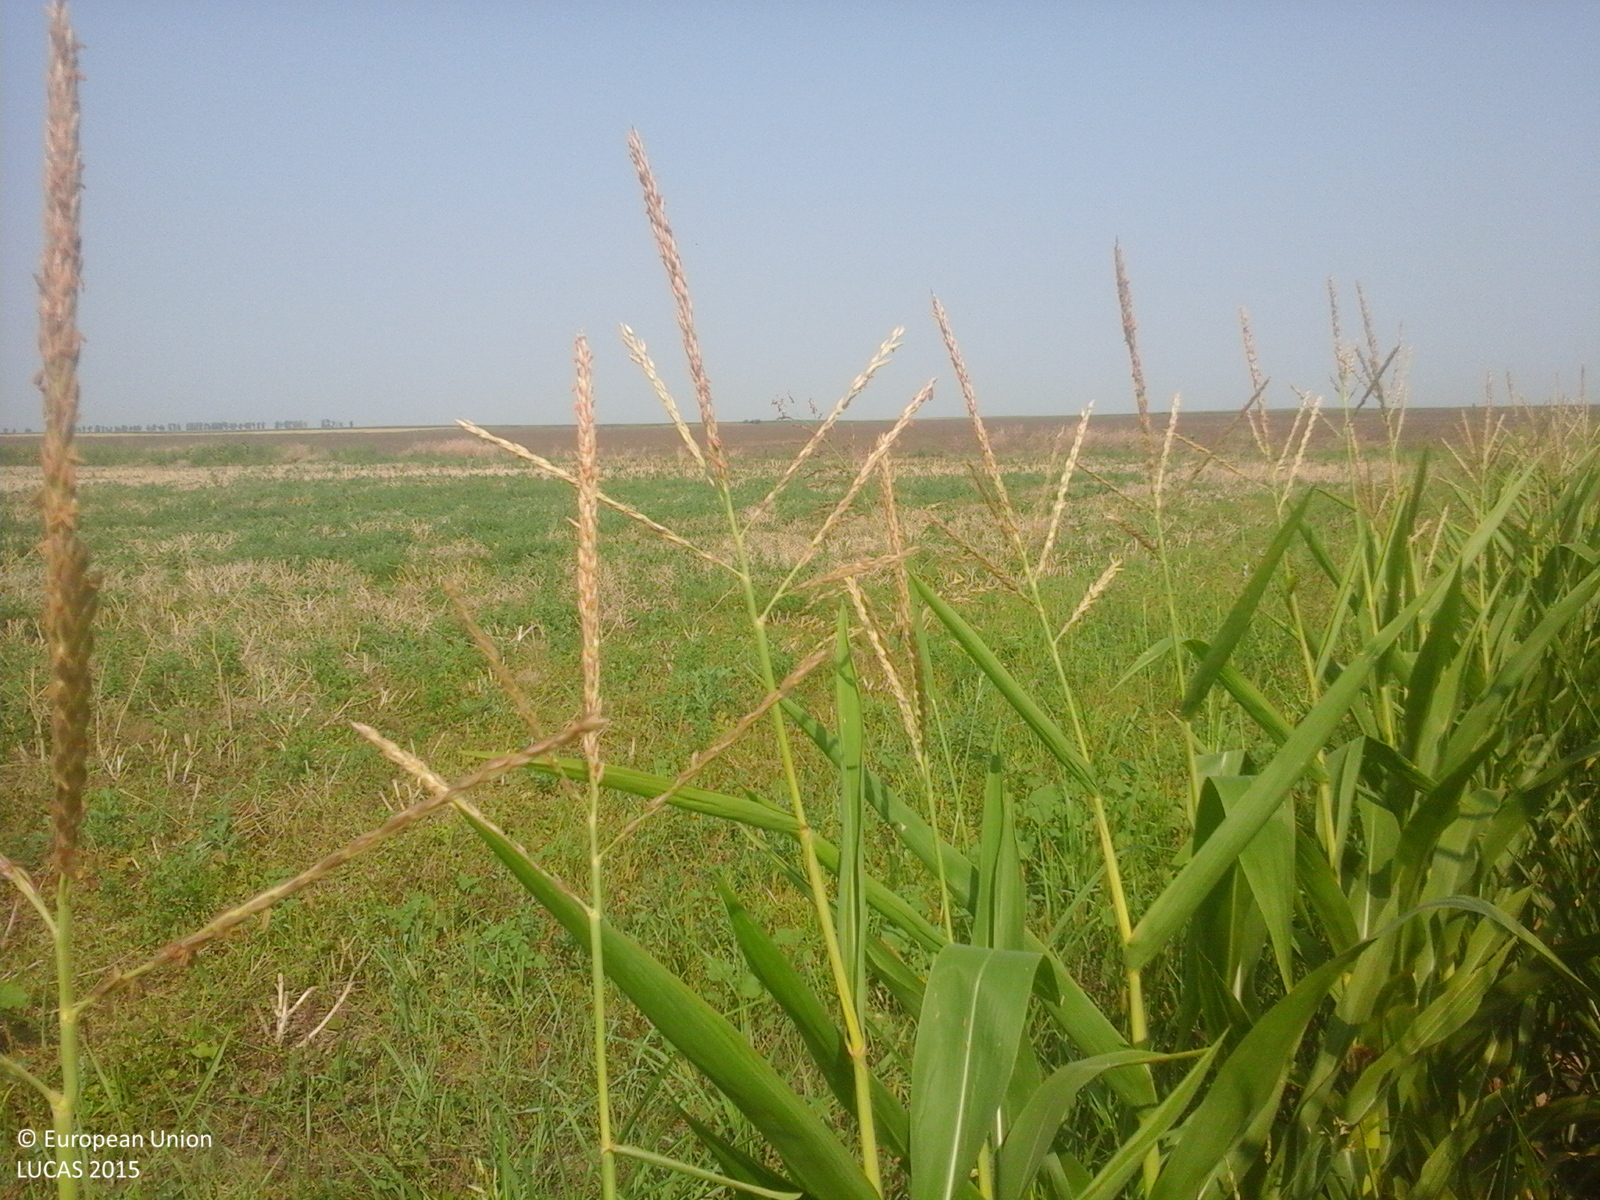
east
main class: Cropland
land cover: Maize
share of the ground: > 75 %
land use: Agriculture (excluding fallow land and kitchen gardens)
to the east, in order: Maize; Rape and turnip rape; Grass margins; Tracks; Grass margins; Common wheat
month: July
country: RO
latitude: 44.9690
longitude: 26.8274
